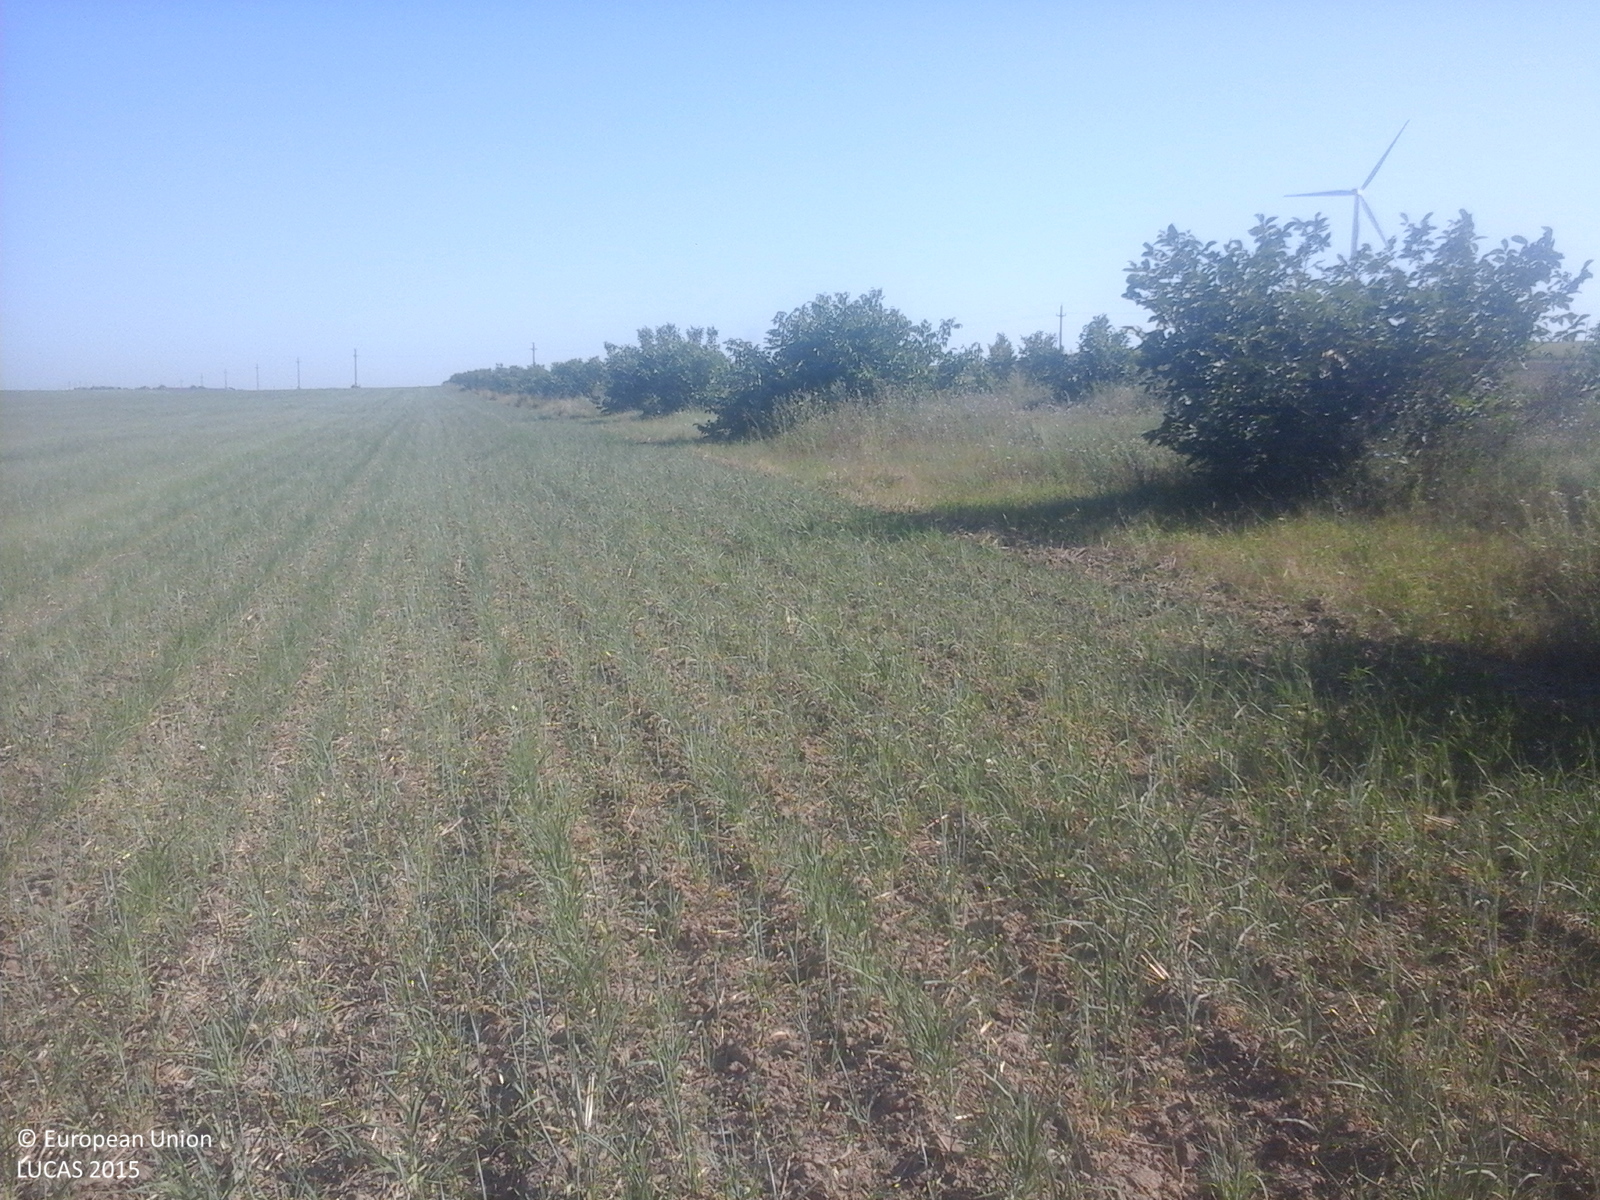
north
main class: Cropland
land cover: Other cereals
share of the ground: > 75 %
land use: Agriculture (excluding fallow land and kitchen gardens)
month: August
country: RO
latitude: 44.5285
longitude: 28.4299
